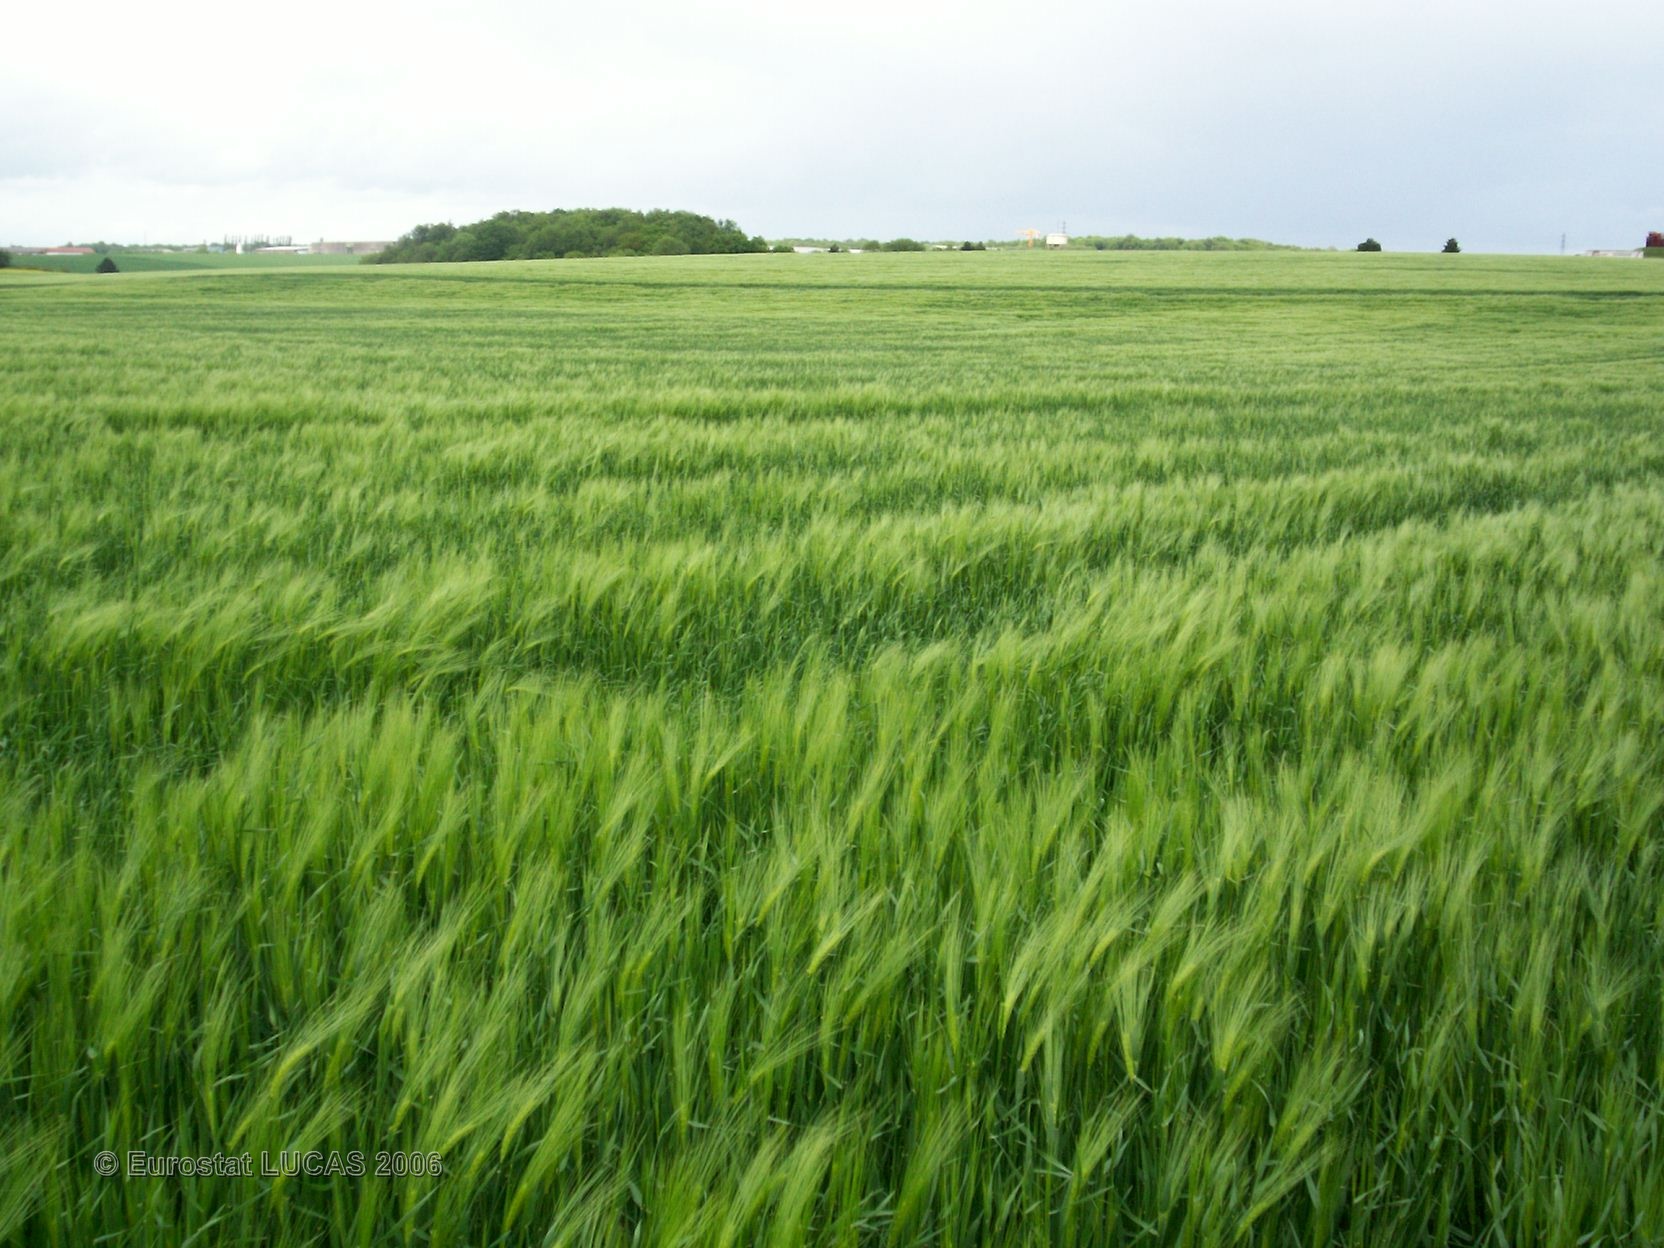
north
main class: Cropland
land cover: Barley
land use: Agriculture (excluding fallow land and kitchen gardens)
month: May
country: FR
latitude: 49.4603
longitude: 5.8463
